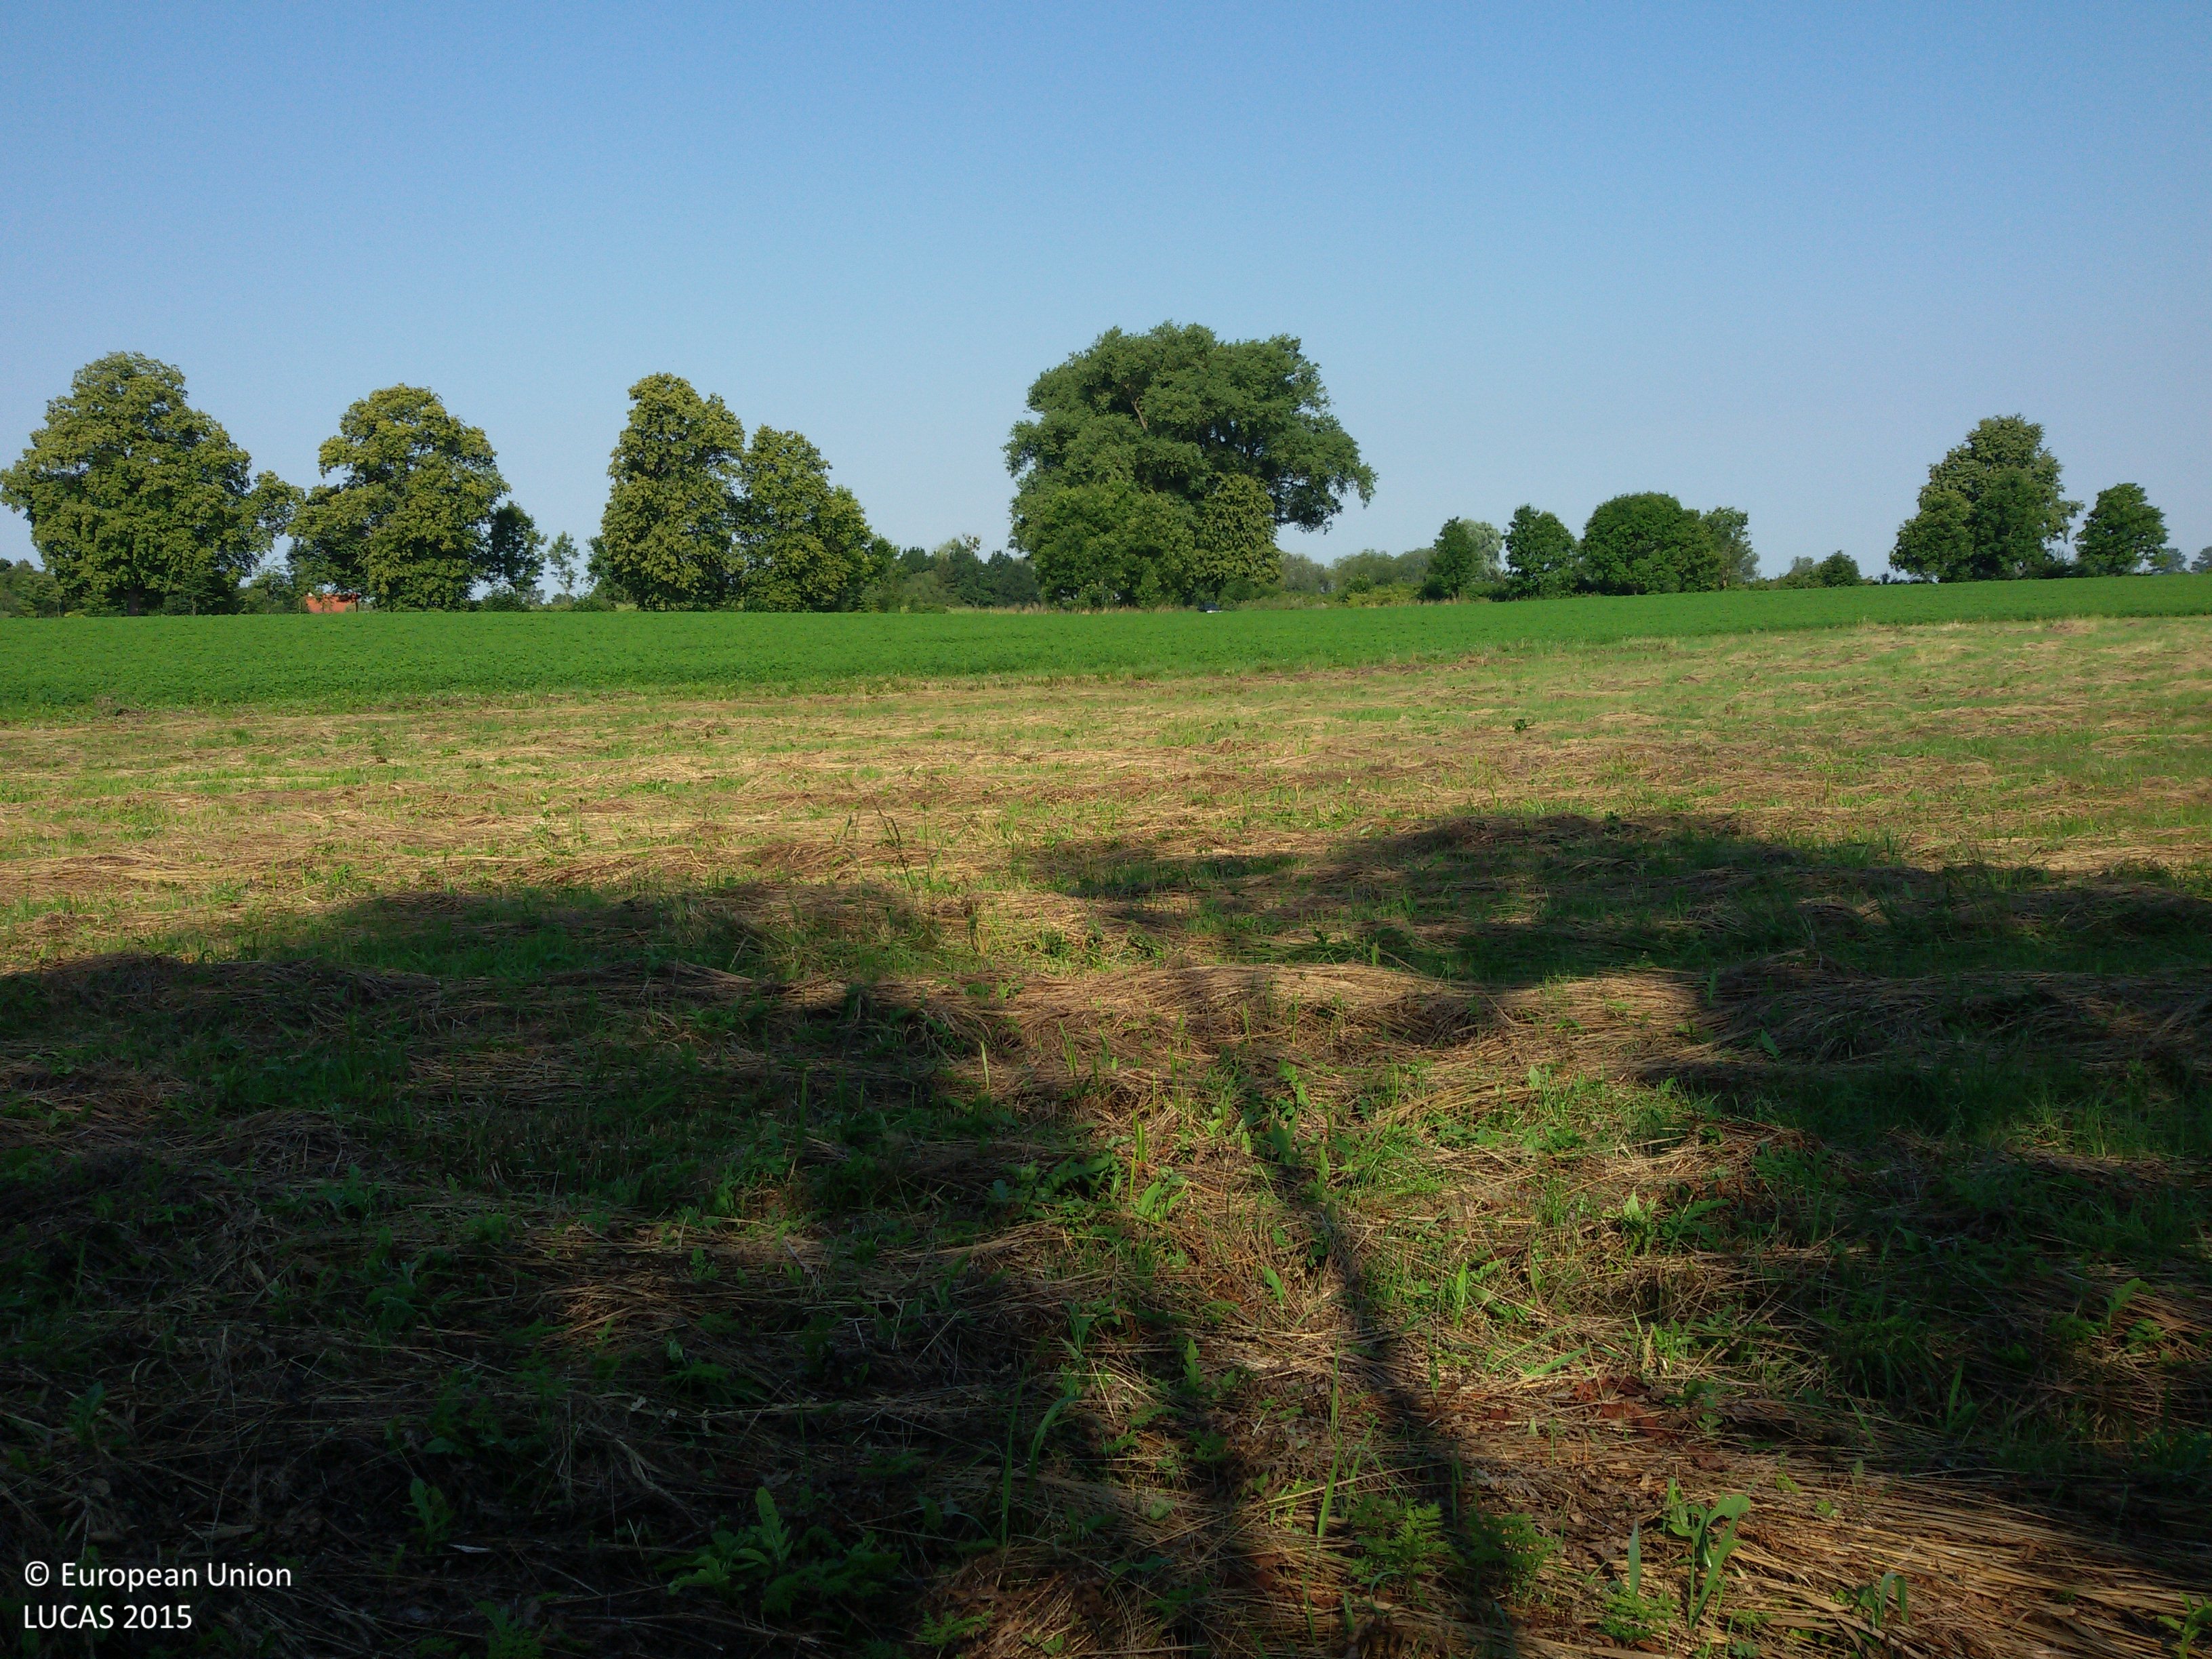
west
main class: Shrubland
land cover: Shrubland with sparse tree cover
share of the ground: > 75 %
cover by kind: shrubs 80 %, herbaceous plants 15 %, broadleaved forest trees 5 %
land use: Semi-natural and natural areas not in use
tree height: > 5 m
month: August
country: PL
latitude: 54.2844
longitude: 21.3367
